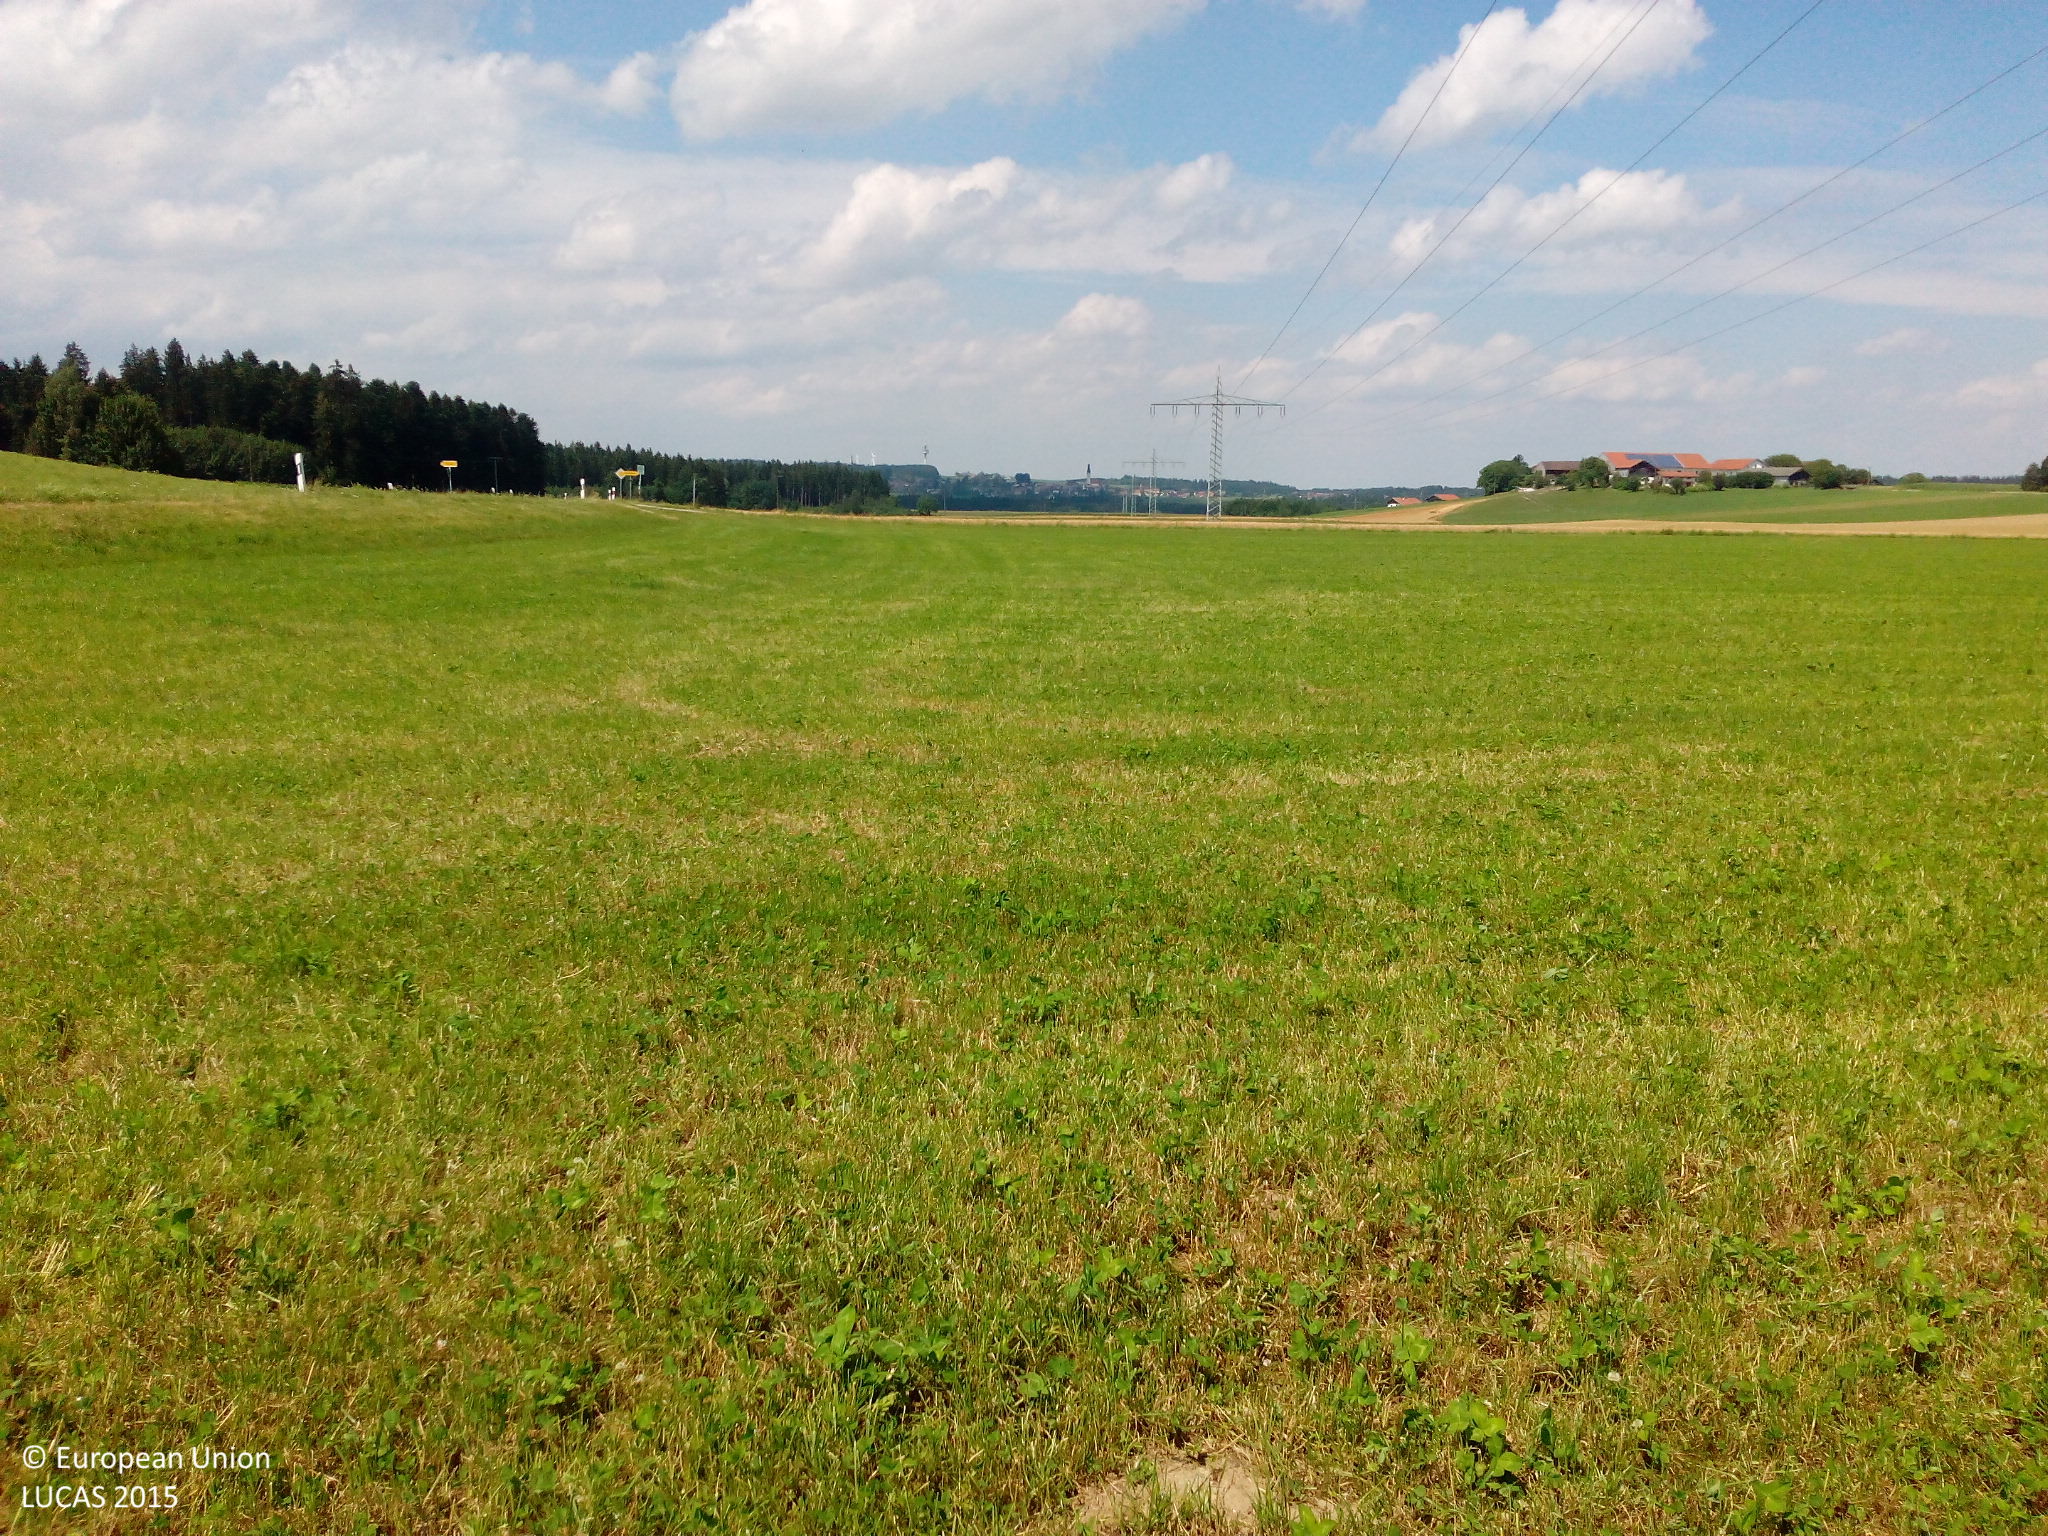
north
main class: Cropland
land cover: Clovers
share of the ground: > 75 %
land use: Agriculture (excluding fallow land and kitchen gardens)
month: July
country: DE
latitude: 48.0360
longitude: 12.3727
